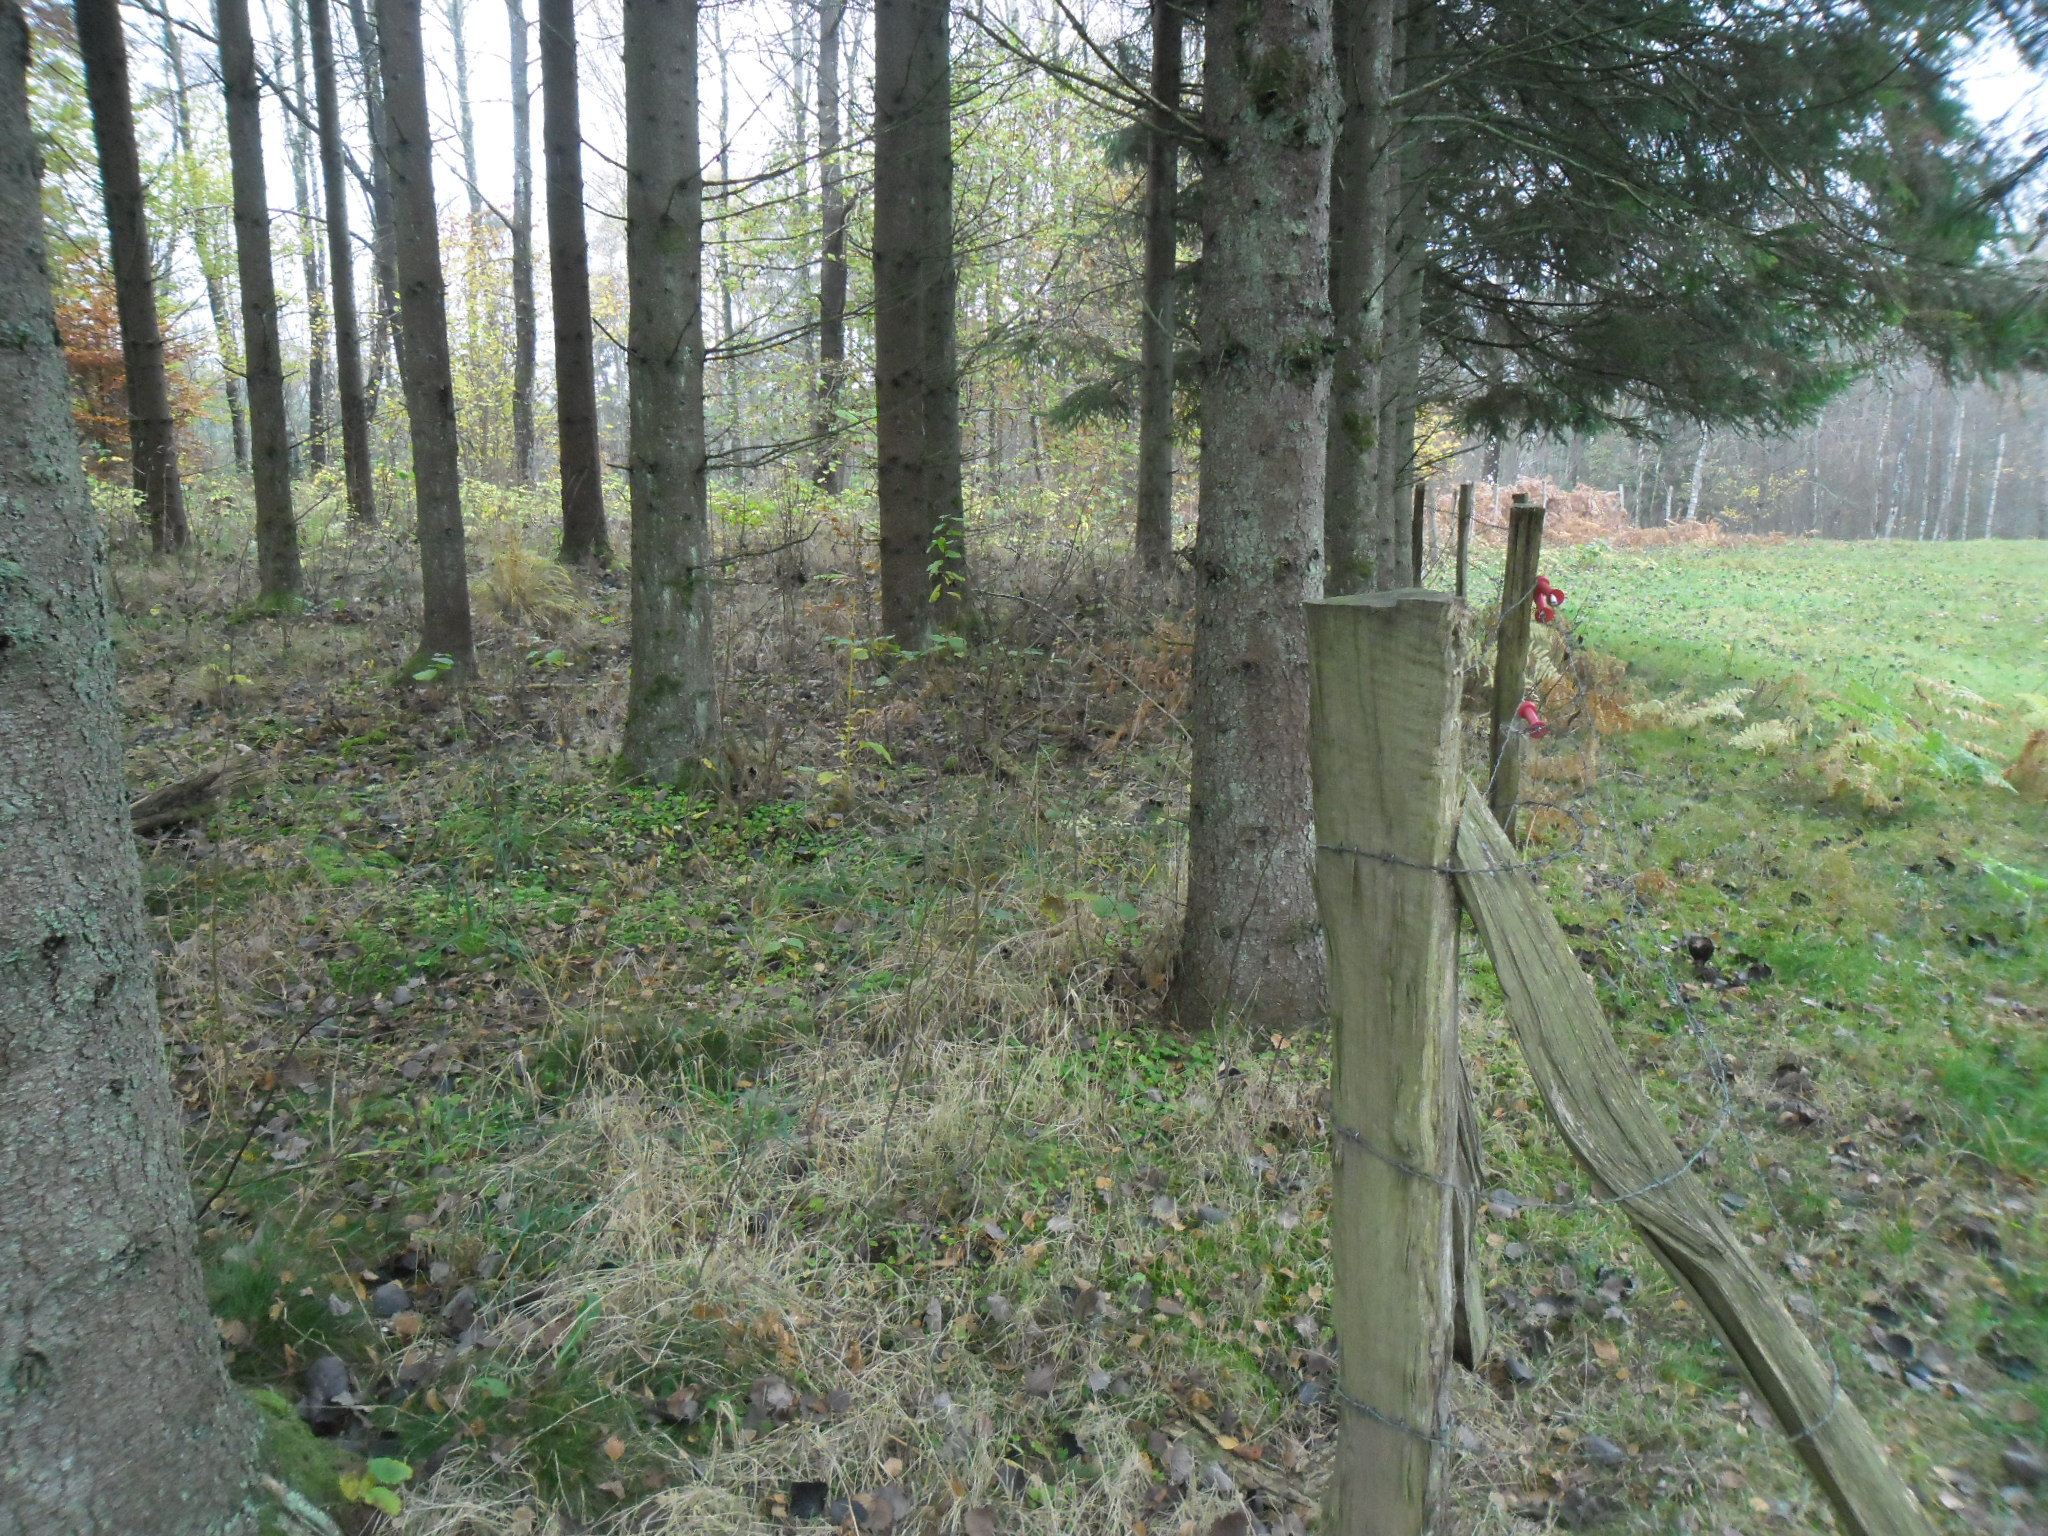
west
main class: Grassland
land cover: Grassland without tree/shrub cover
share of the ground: > 75 %
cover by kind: herbaceous plants 100 %
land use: Agriculture (excluding fallow land and kitchen gardens)
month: November
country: SE
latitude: 56.2767
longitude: 13.0820
